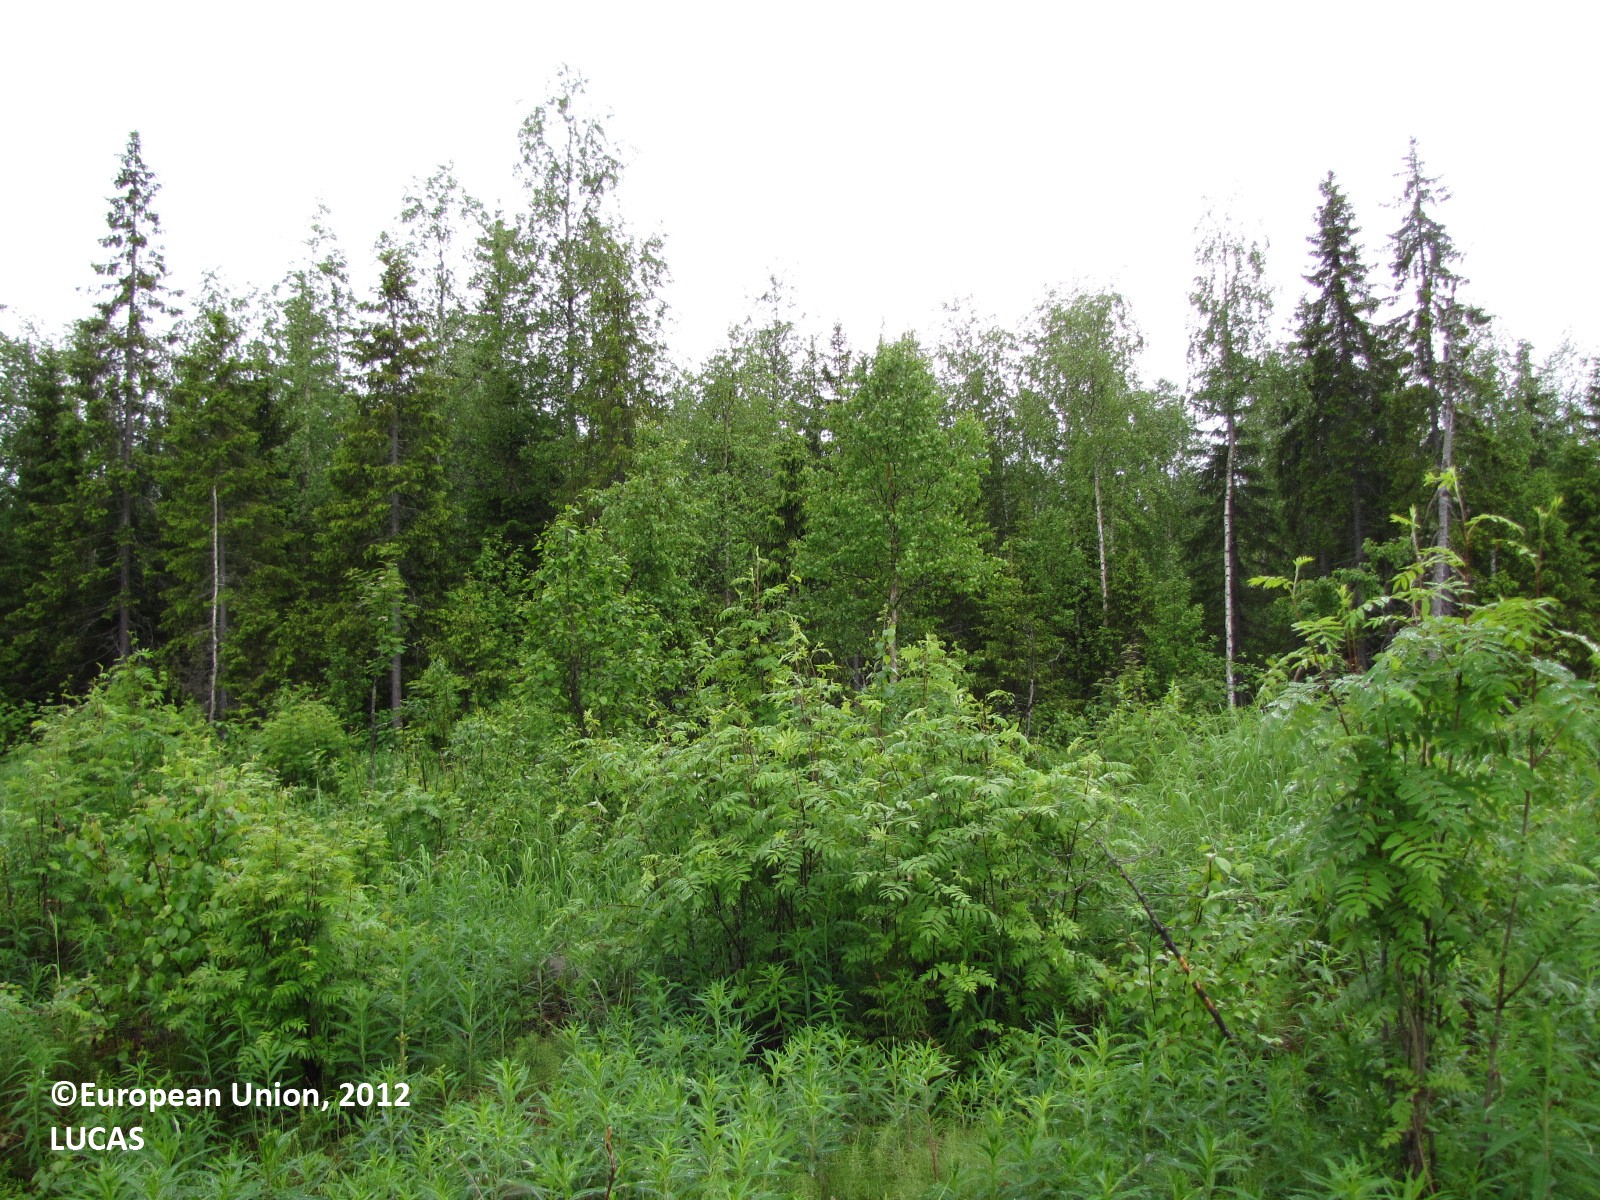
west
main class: Grassland
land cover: Grassland with sparse tree/shrub cover
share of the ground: > 75 %
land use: Forestry
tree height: < 5 m
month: June
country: FI
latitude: 65.9955
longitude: 24.3008
